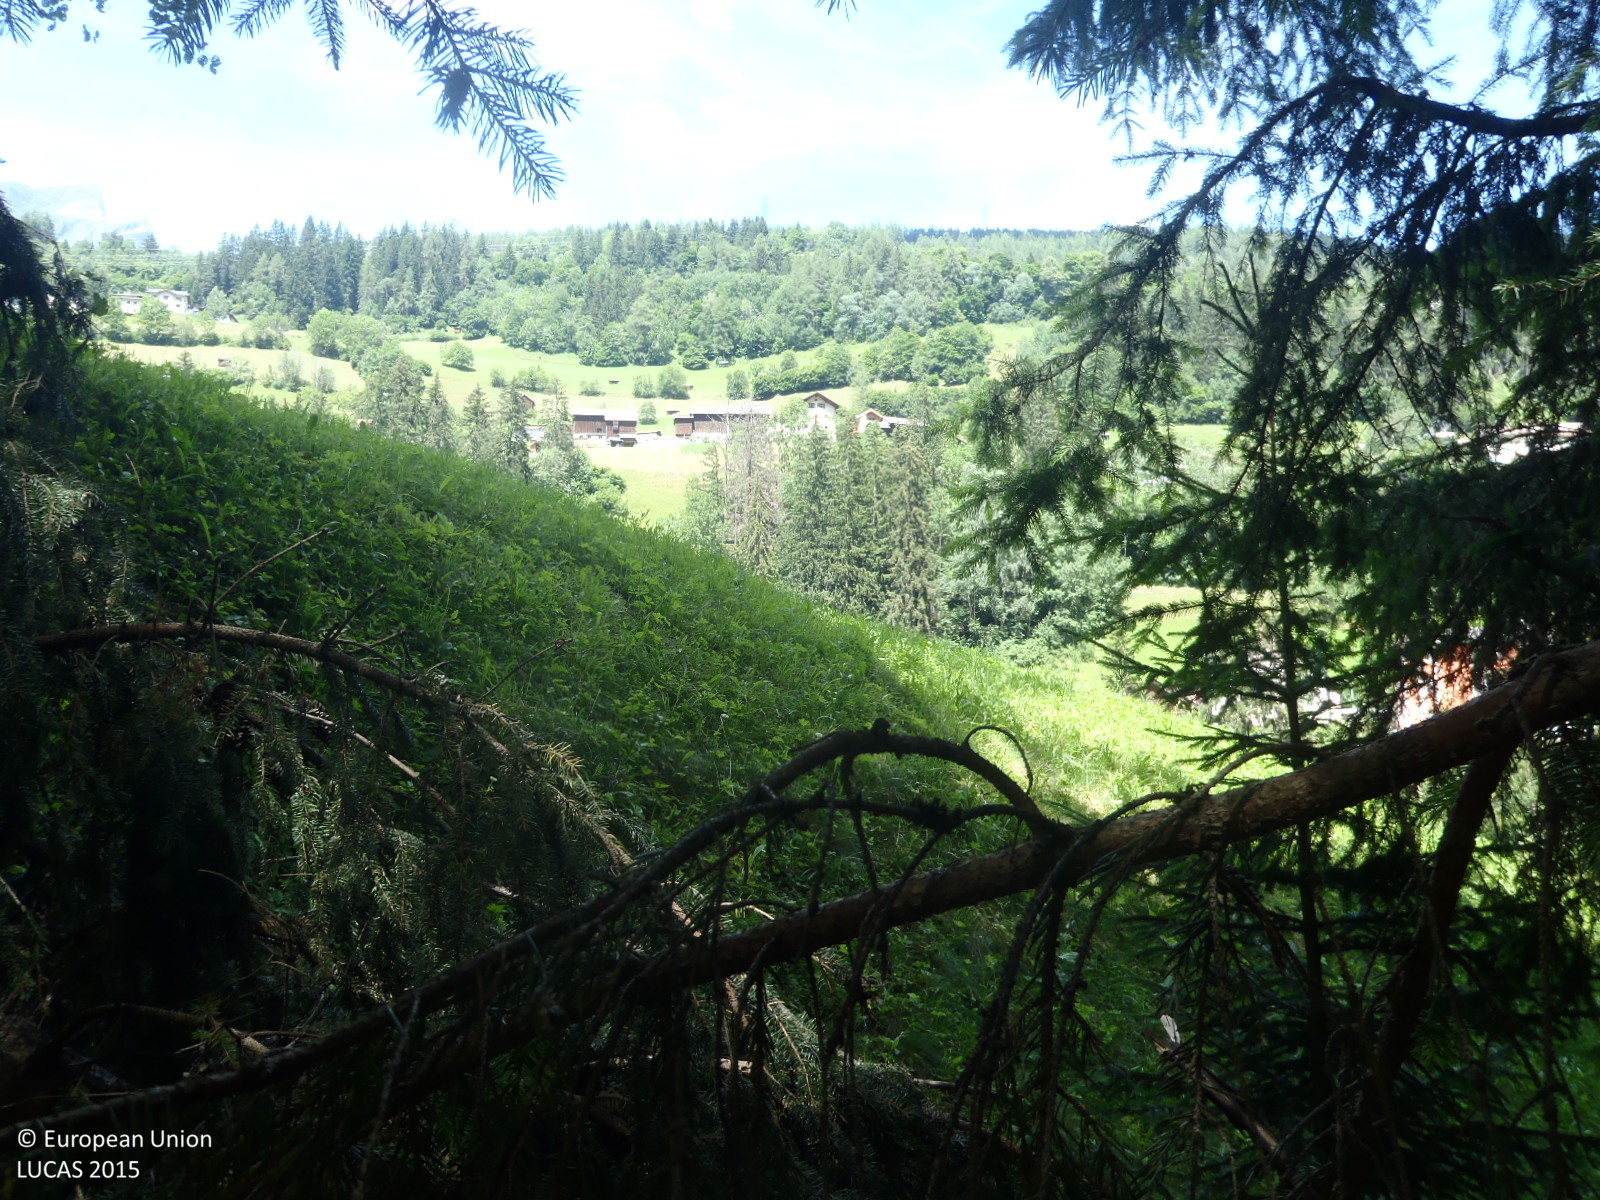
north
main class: Woodland
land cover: Spruce dominated mixed woodland
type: alpine coniferous forest
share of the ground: > 75 %
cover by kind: coniferous forest trees 75 %, broadleaved forest trees 25 %
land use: Forestry
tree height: > 5 m
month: June
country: AT
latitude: 47.1246
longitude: 10.4609
